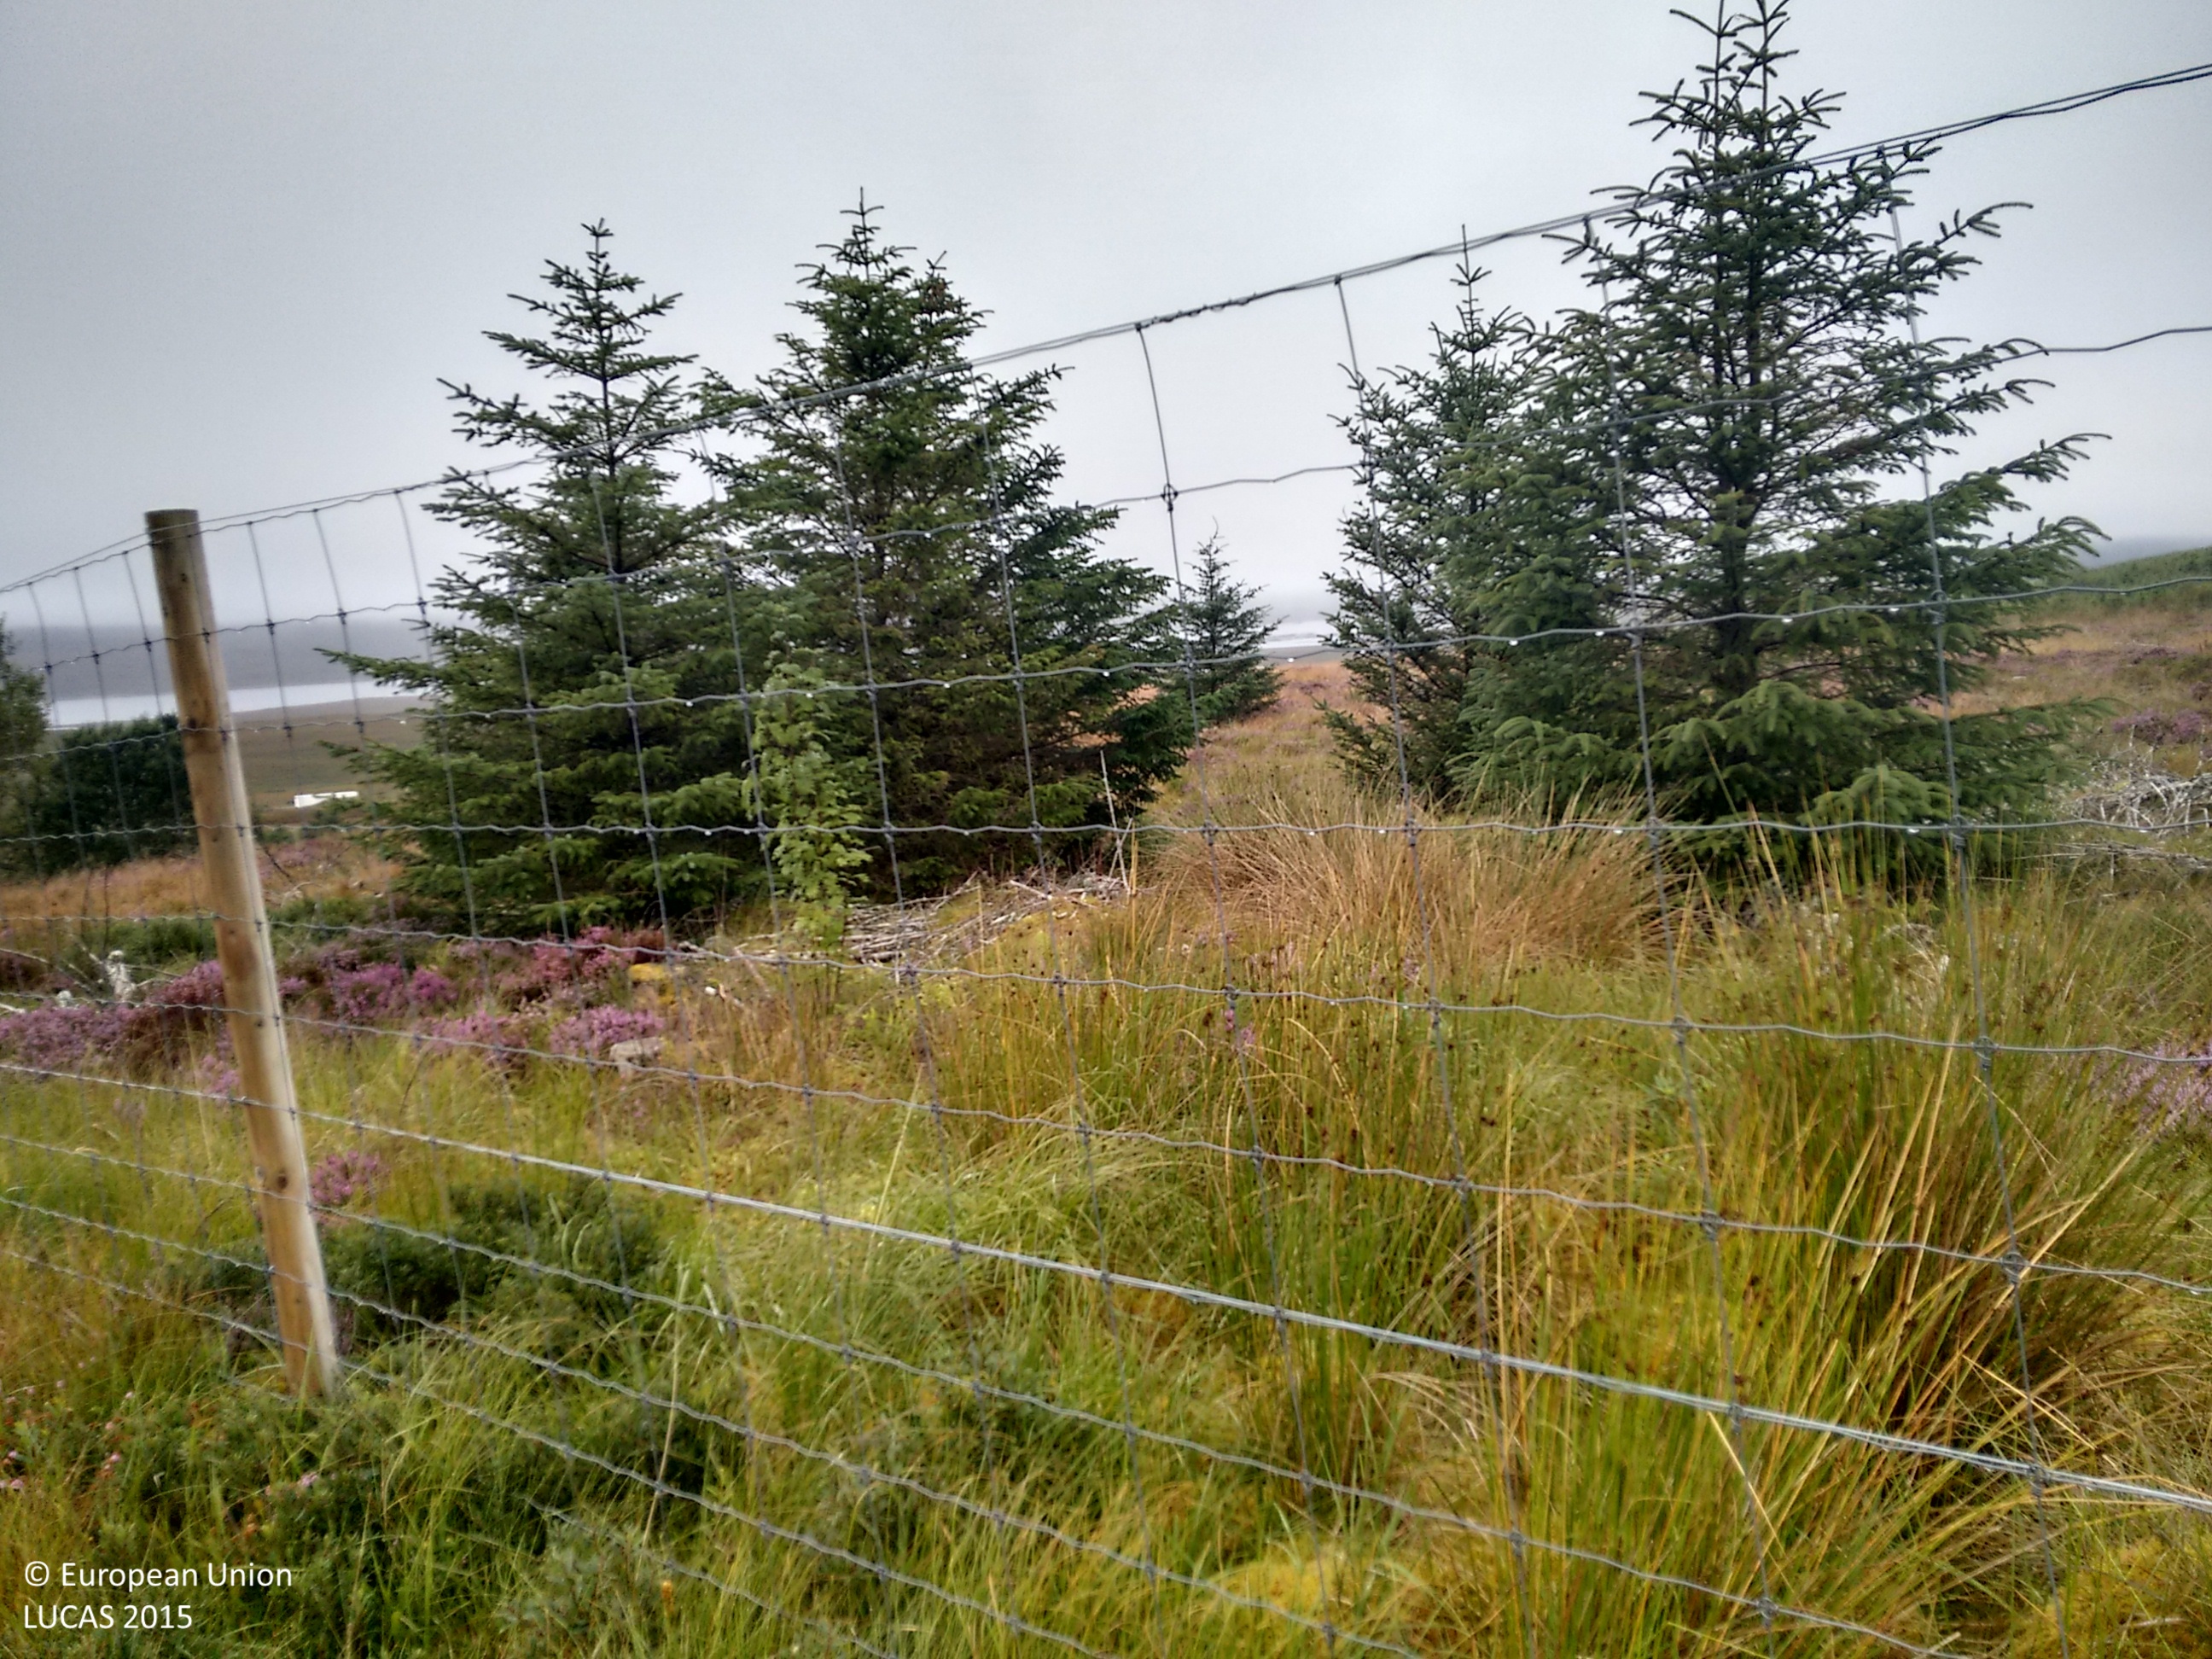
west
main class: Shrubland
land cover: Shrubland with sparse tree cover
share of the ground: > 75 %
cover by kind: herbaceous plants 55 %, shrubs 40 %, coniferous forest trees 5 %
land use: Forestry
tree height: > 5 m
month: September
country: GB
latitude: 58.1372
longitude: -4.5419
